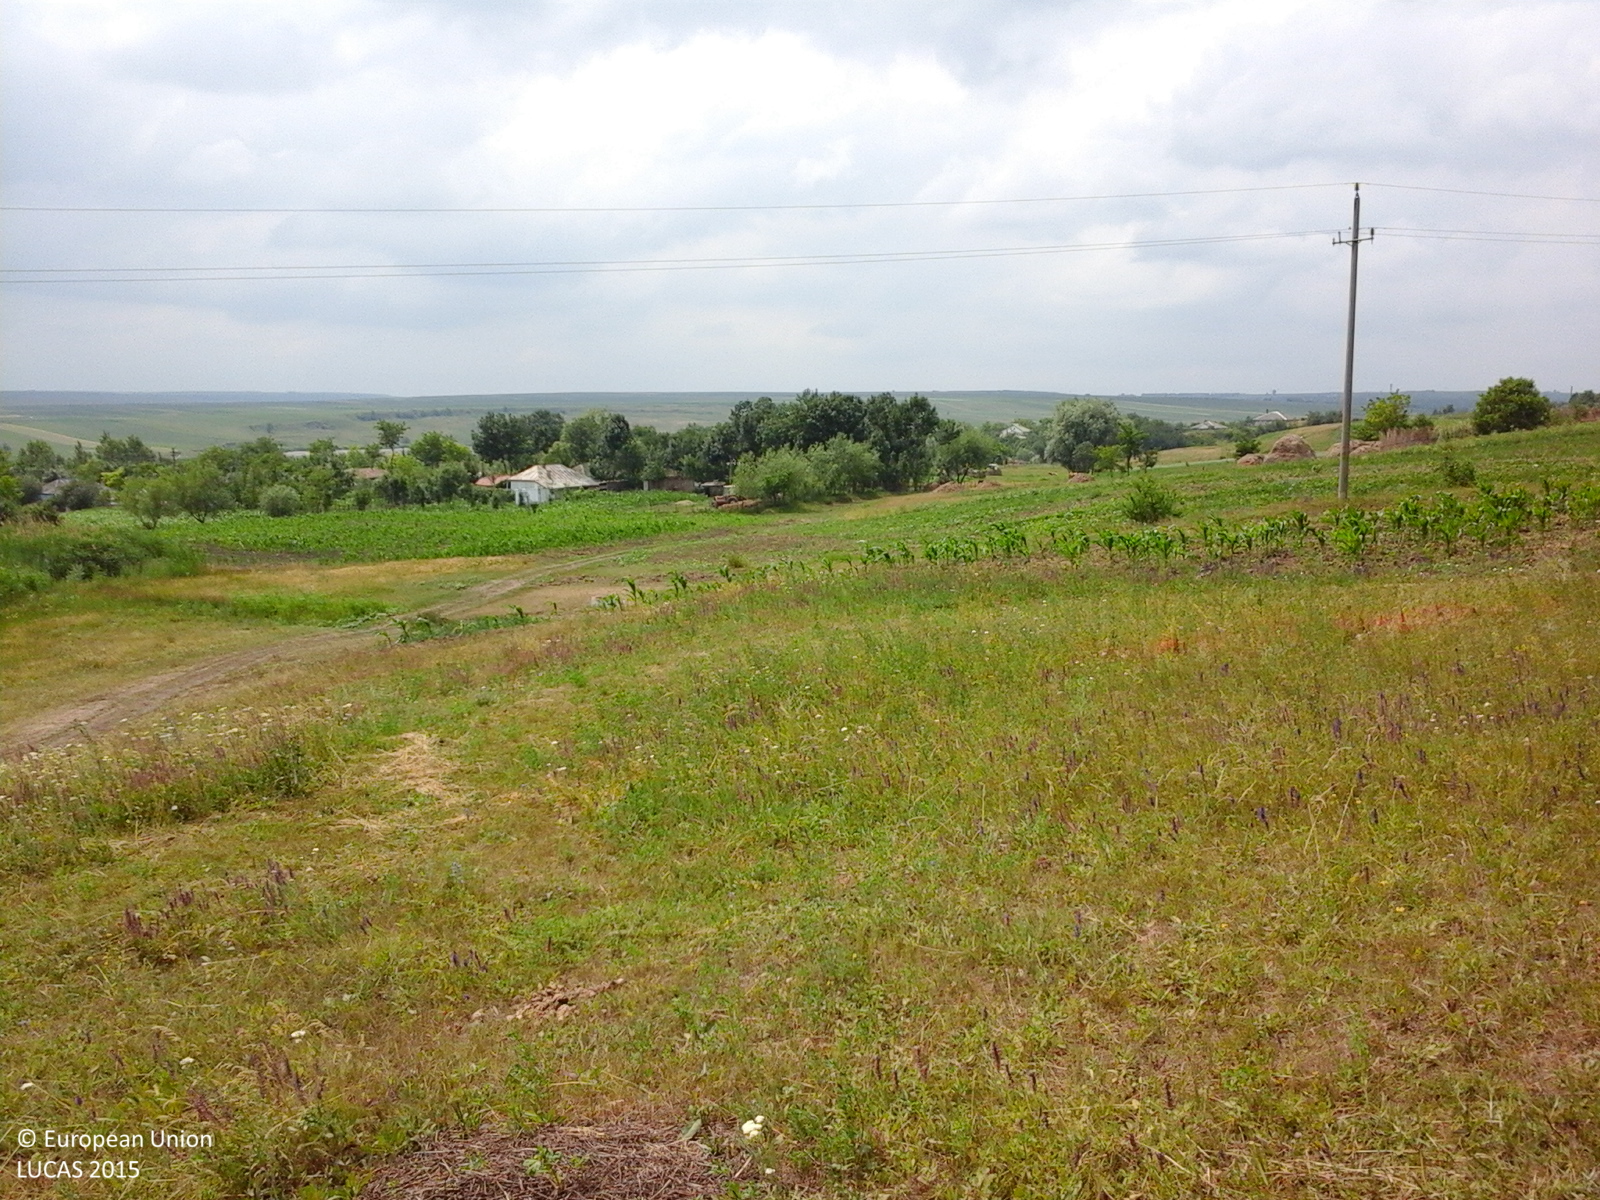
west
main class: Grassland
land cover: Grassland without tree/shrub cover
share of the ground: > 75 %
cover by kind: herbaceous plants 100 %
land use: Agriculture (excluding fallow land and kitchen gardens)
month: June
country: RO
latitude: 48.0590
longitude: 26.6958
